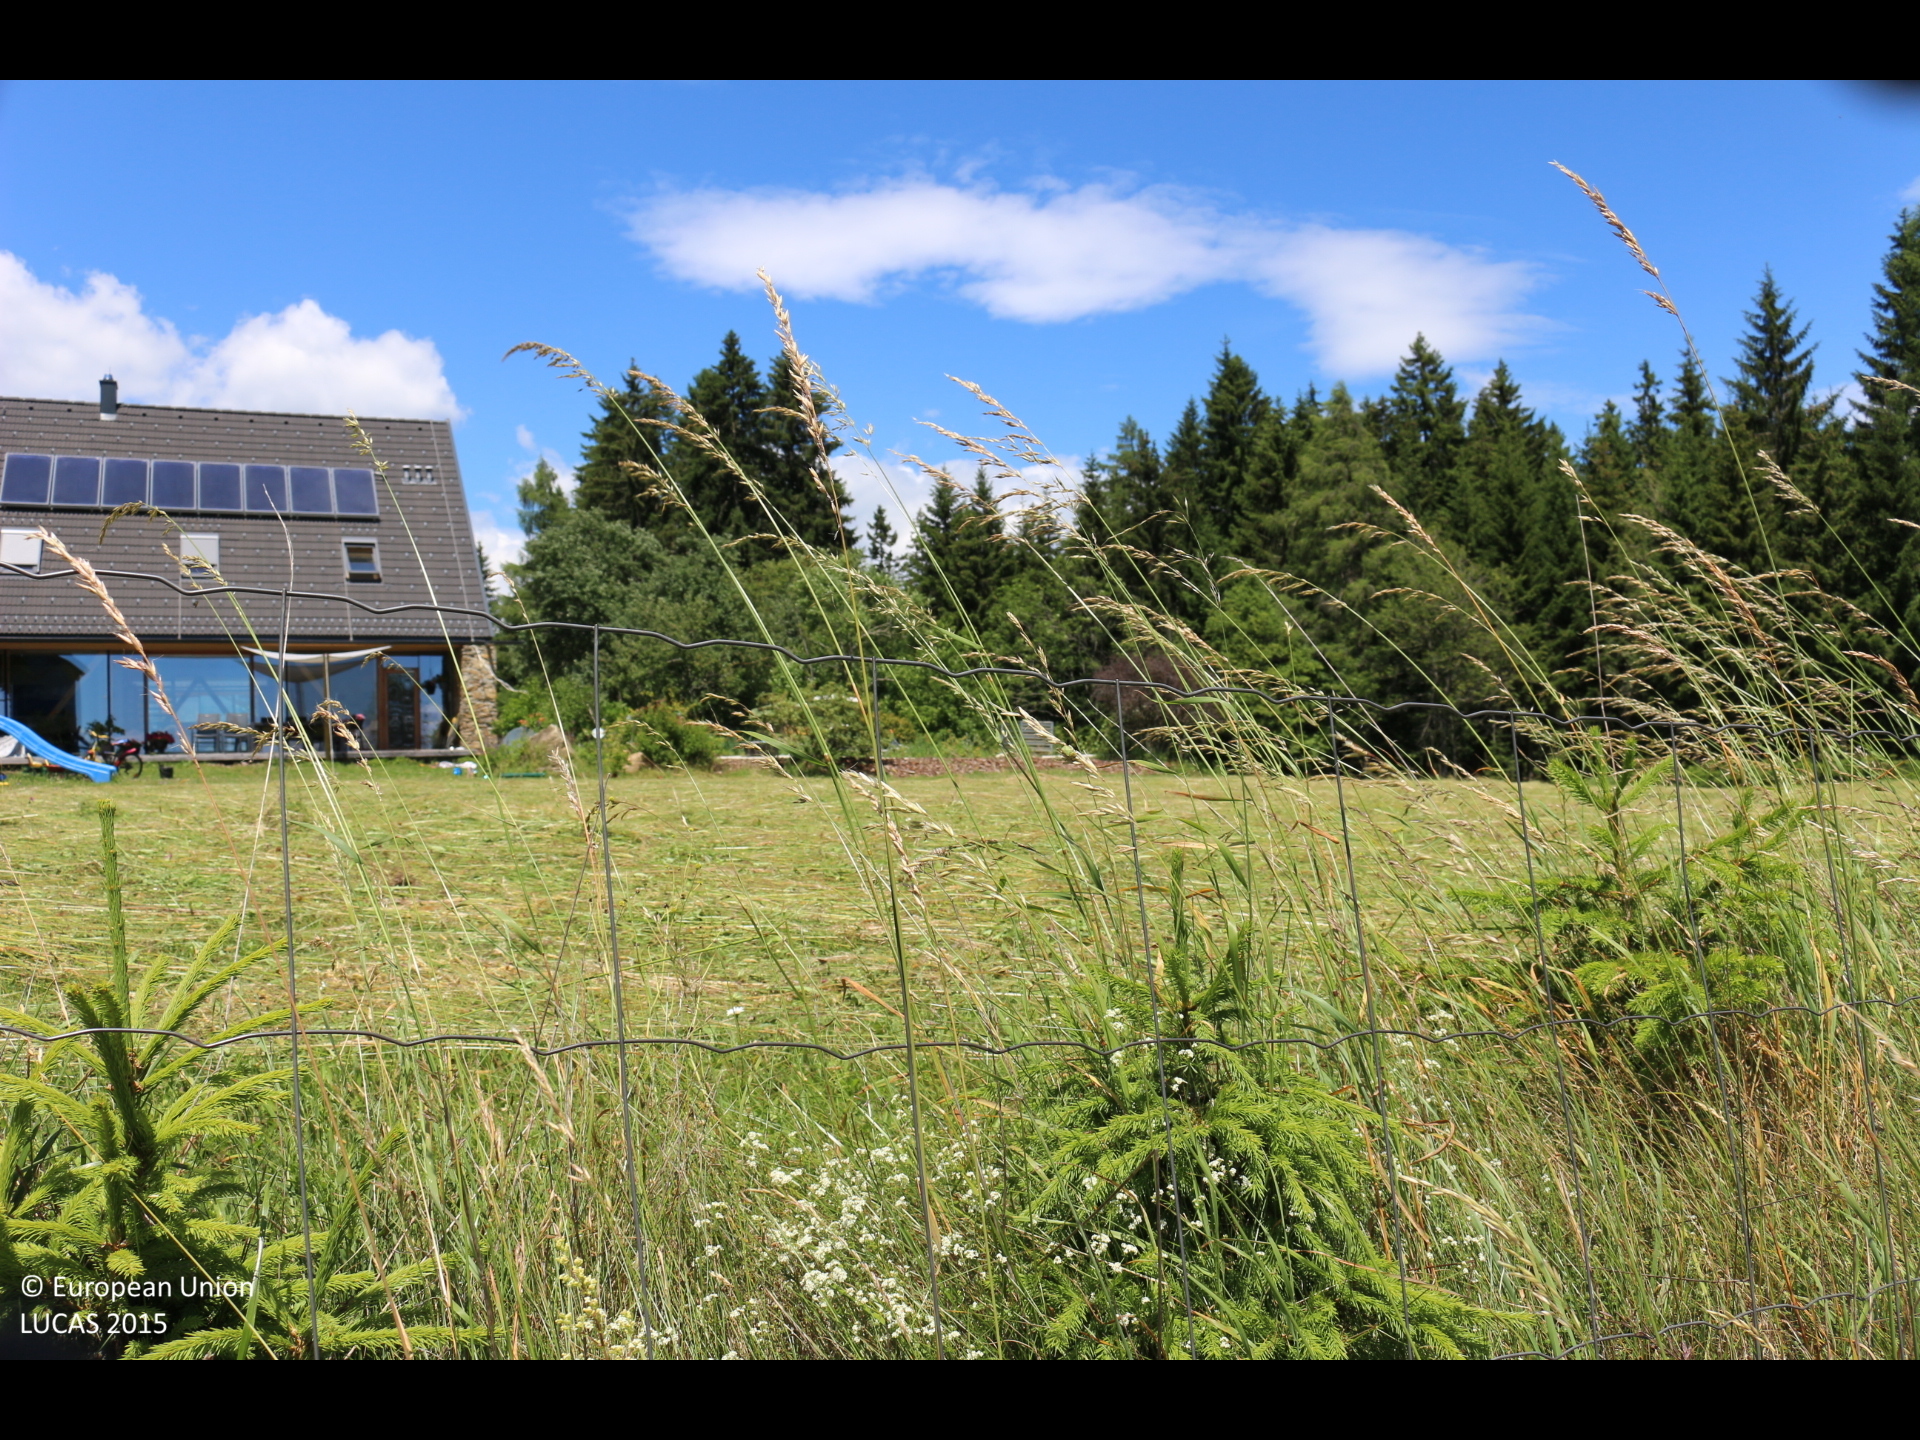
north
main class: Grassland
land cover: Grassland without tree/shrub cover
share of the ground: > 75 %
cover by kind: herbaceous plants 100 %
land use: Agriculture (excluding fallow land and kitchen gardens)
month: June
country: AT
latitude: 46.8763
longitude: 14.3410
